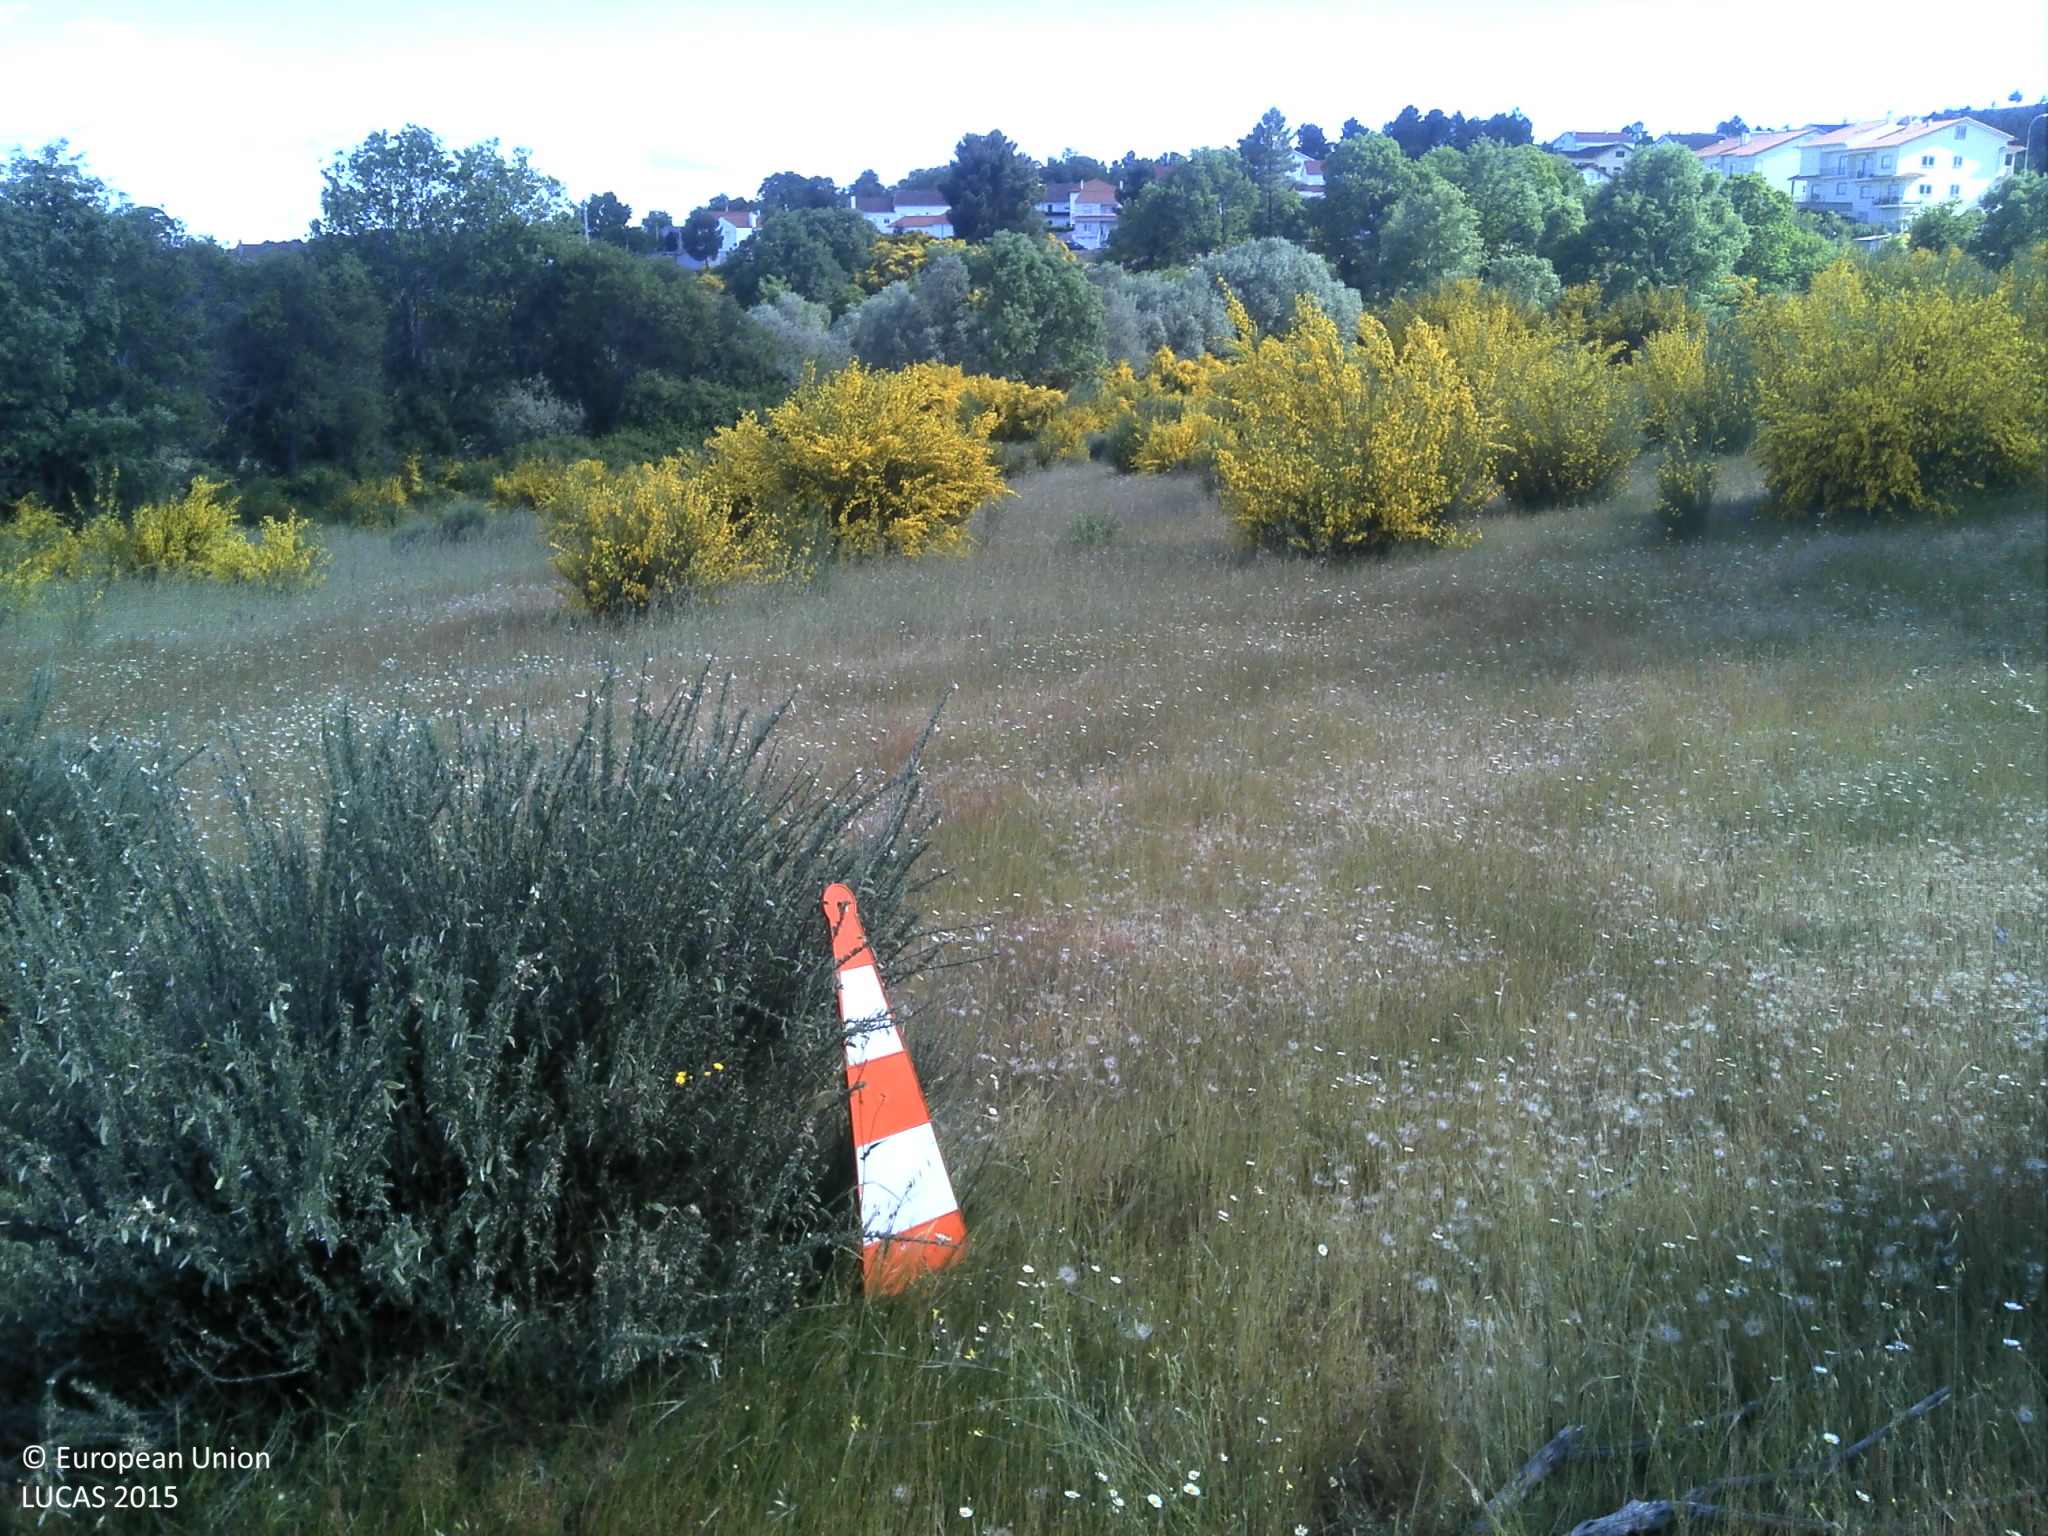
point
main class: Grassland
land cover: Grassland with sparse tree/shrub cover
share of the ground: 50 - 75 %
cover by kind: herbaceous plants 70 %, unconsolidated bare surface 20 %, broadleaved forest trees 5 %, shrubs 5 %
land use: Agriculture (excluding fallow land and kitchen gardens)
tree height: > 5 m
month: May
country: PT
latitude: 40.5366
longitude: -7.2358
